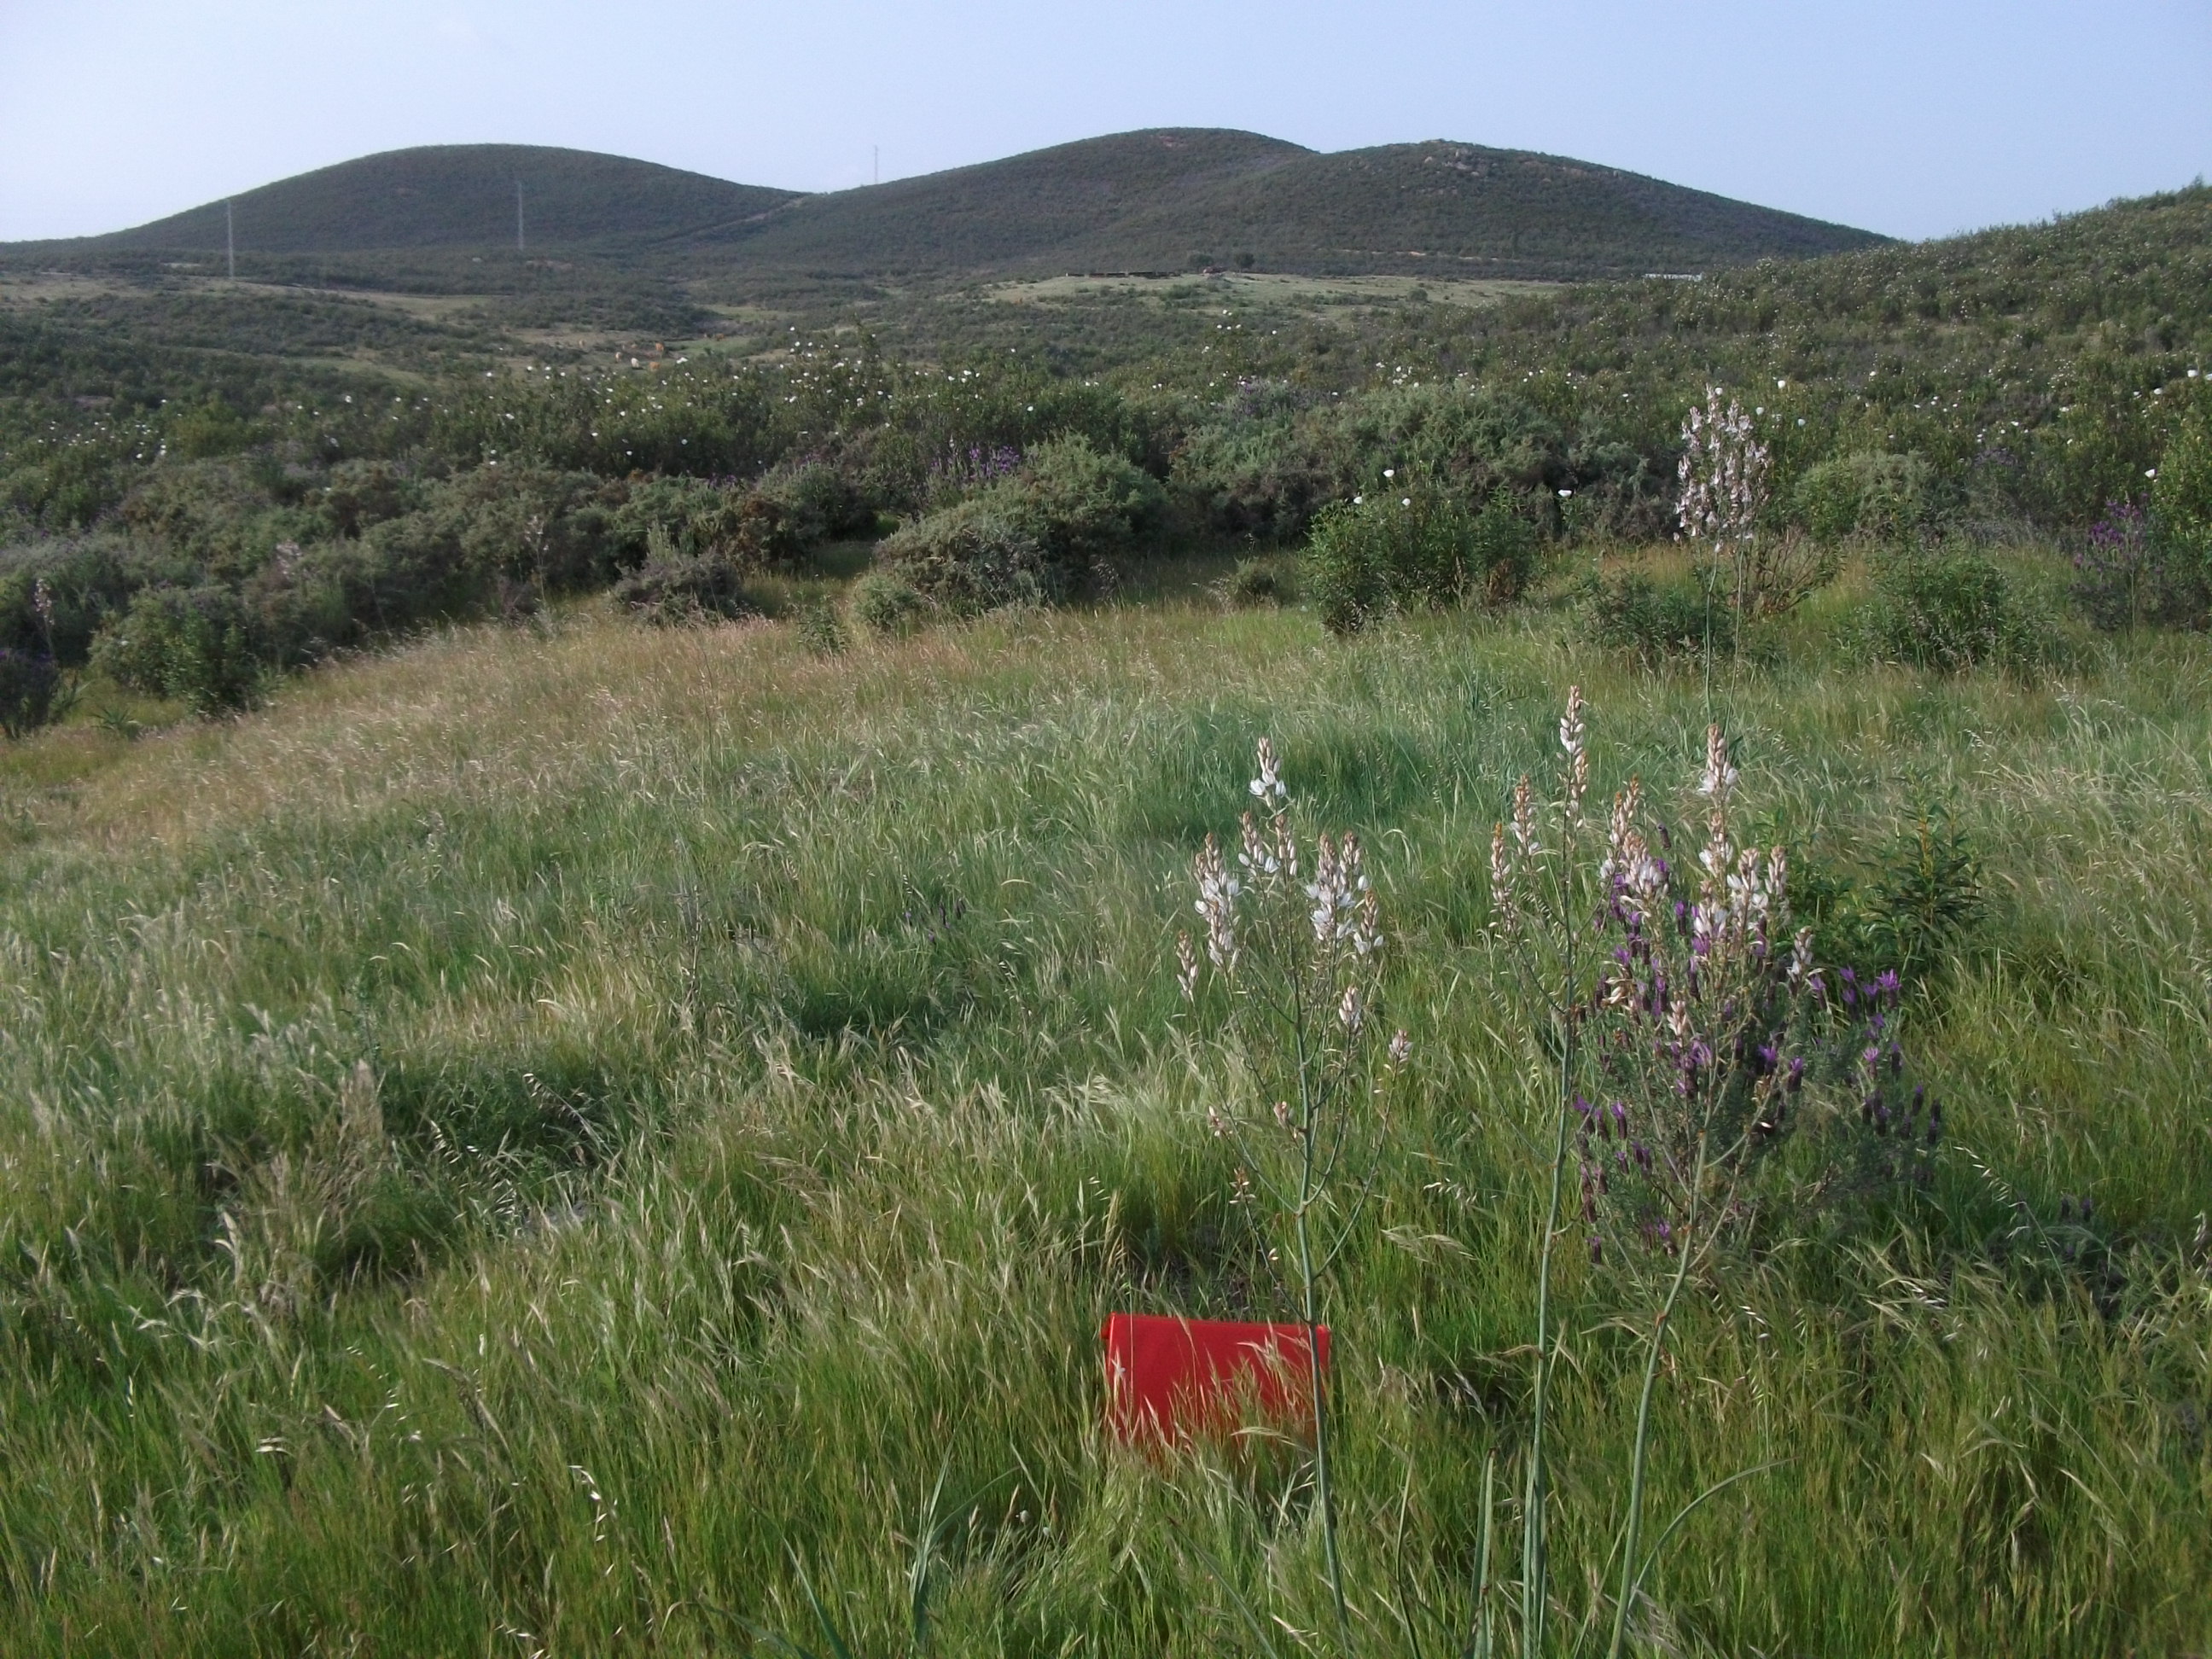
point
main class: Grassland
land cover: Grassland without tree/shrub cover
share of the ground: > 75 %
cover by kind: herbaceous plants 95 %, shrubs 5 %
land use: Agriculture (excluding fallow land and kitchen gardens)
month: April
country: ES
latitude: 37.7559
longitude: -6.6943
